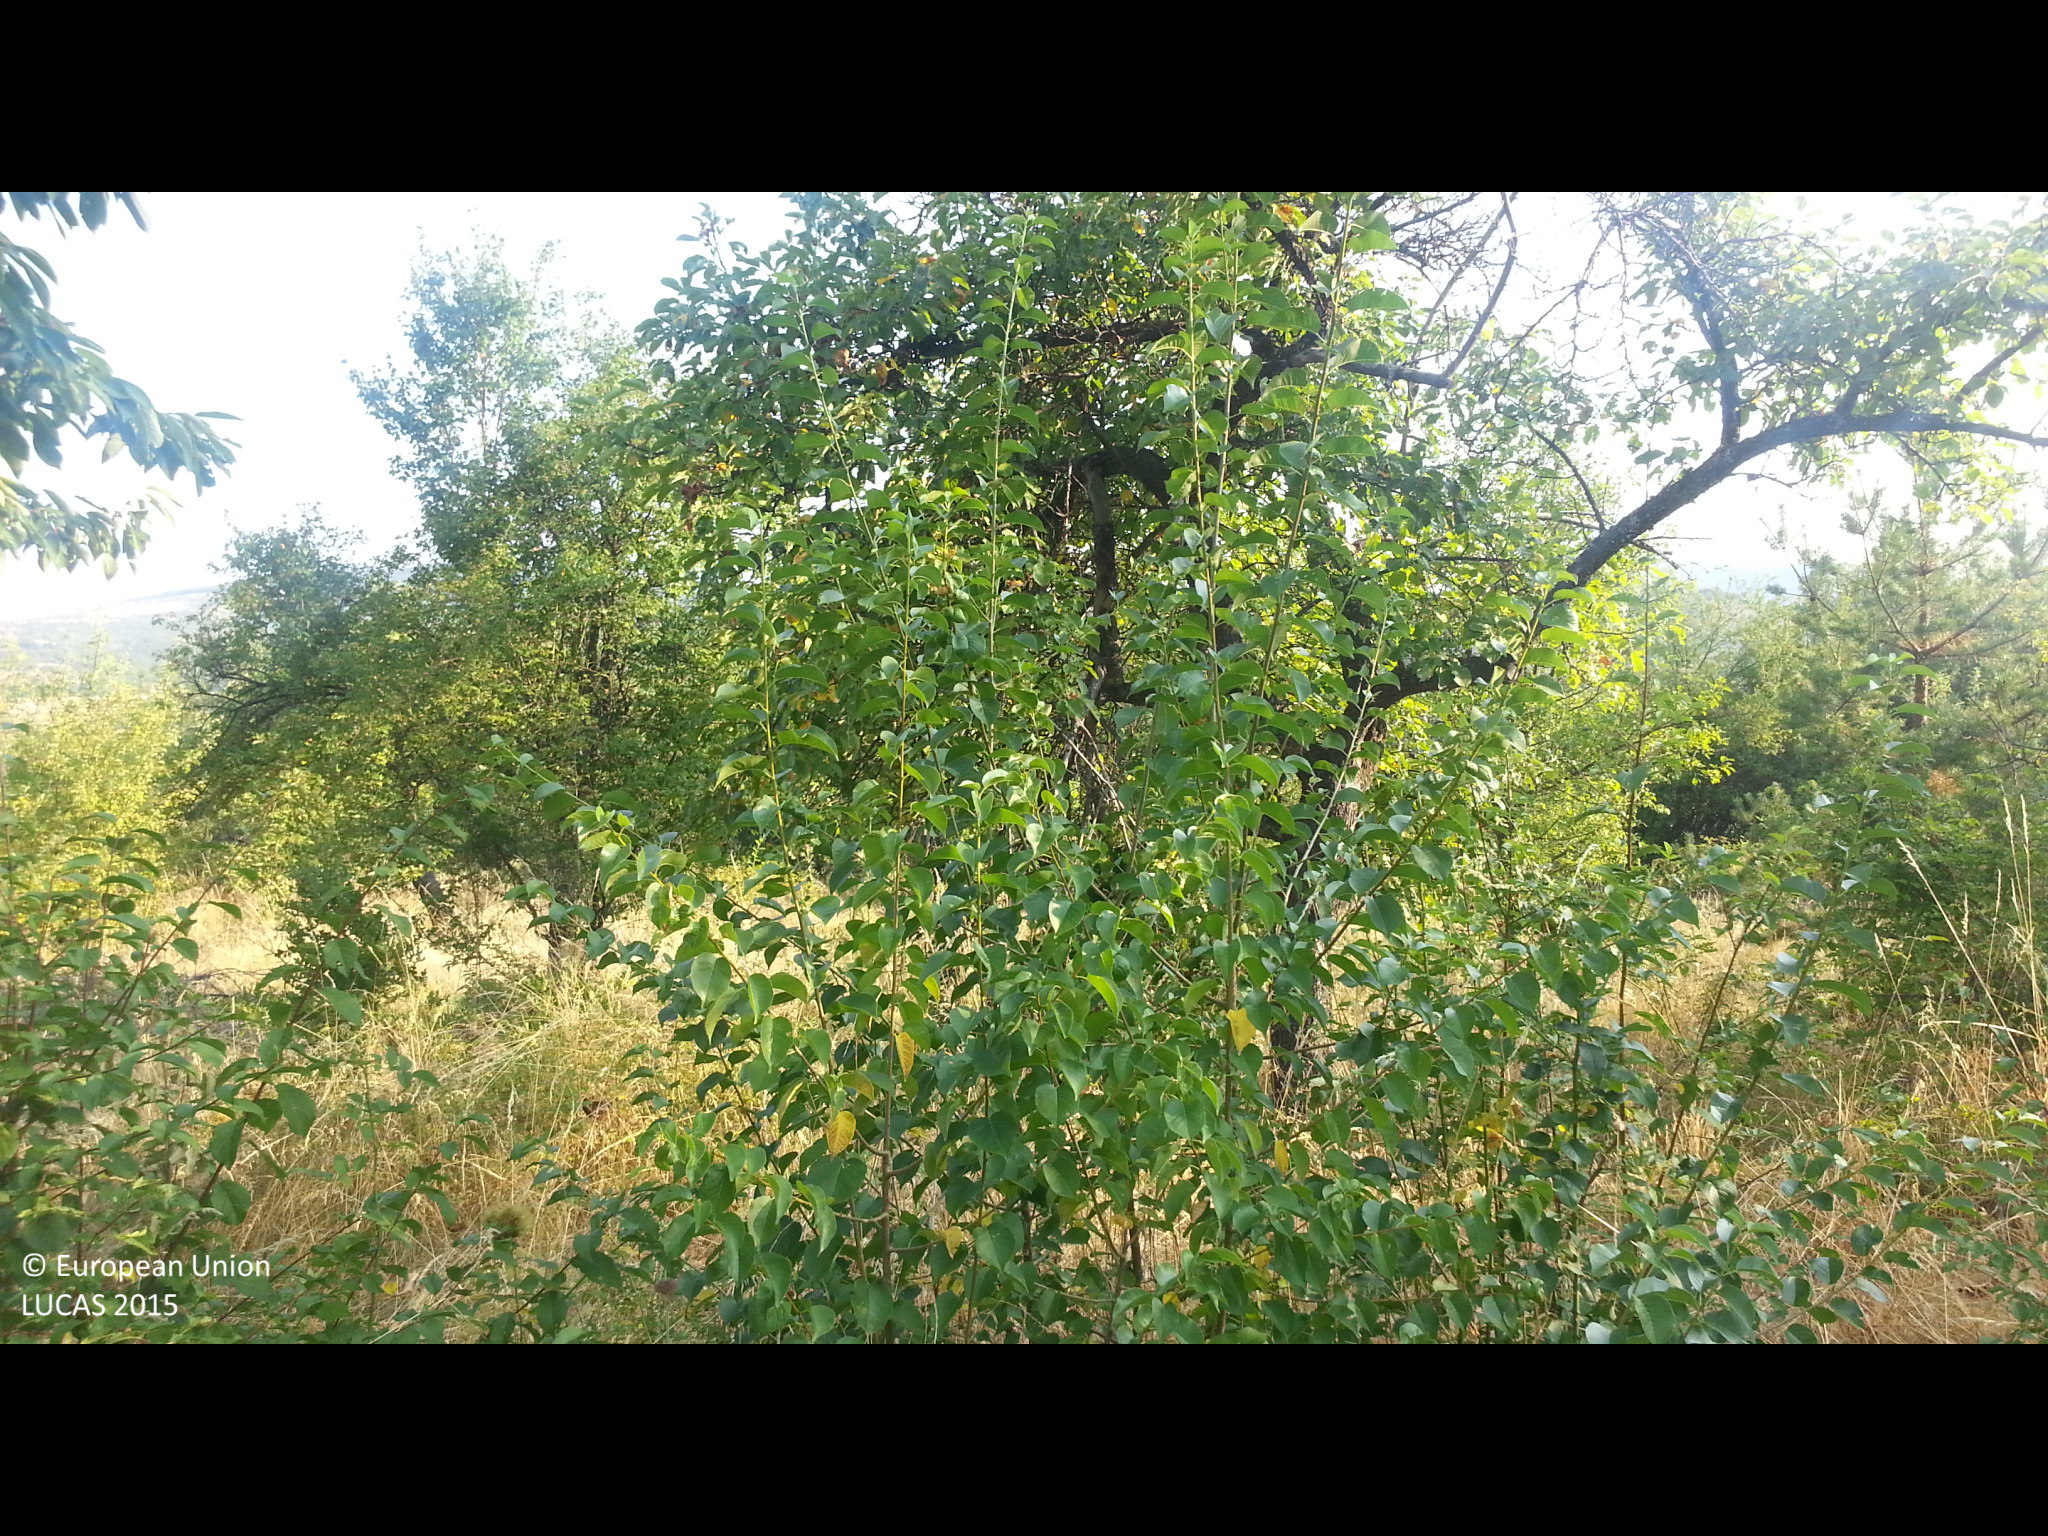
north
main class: Cropland
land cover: Cherry fruit
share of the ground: > 75 %
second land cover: Spontaneously vegetated surfaces
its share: > 75 %
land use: Agriculture (excluding fallow land and kitchen gardens)
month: August
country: BG
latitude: 42.4025
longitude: 22.6704
